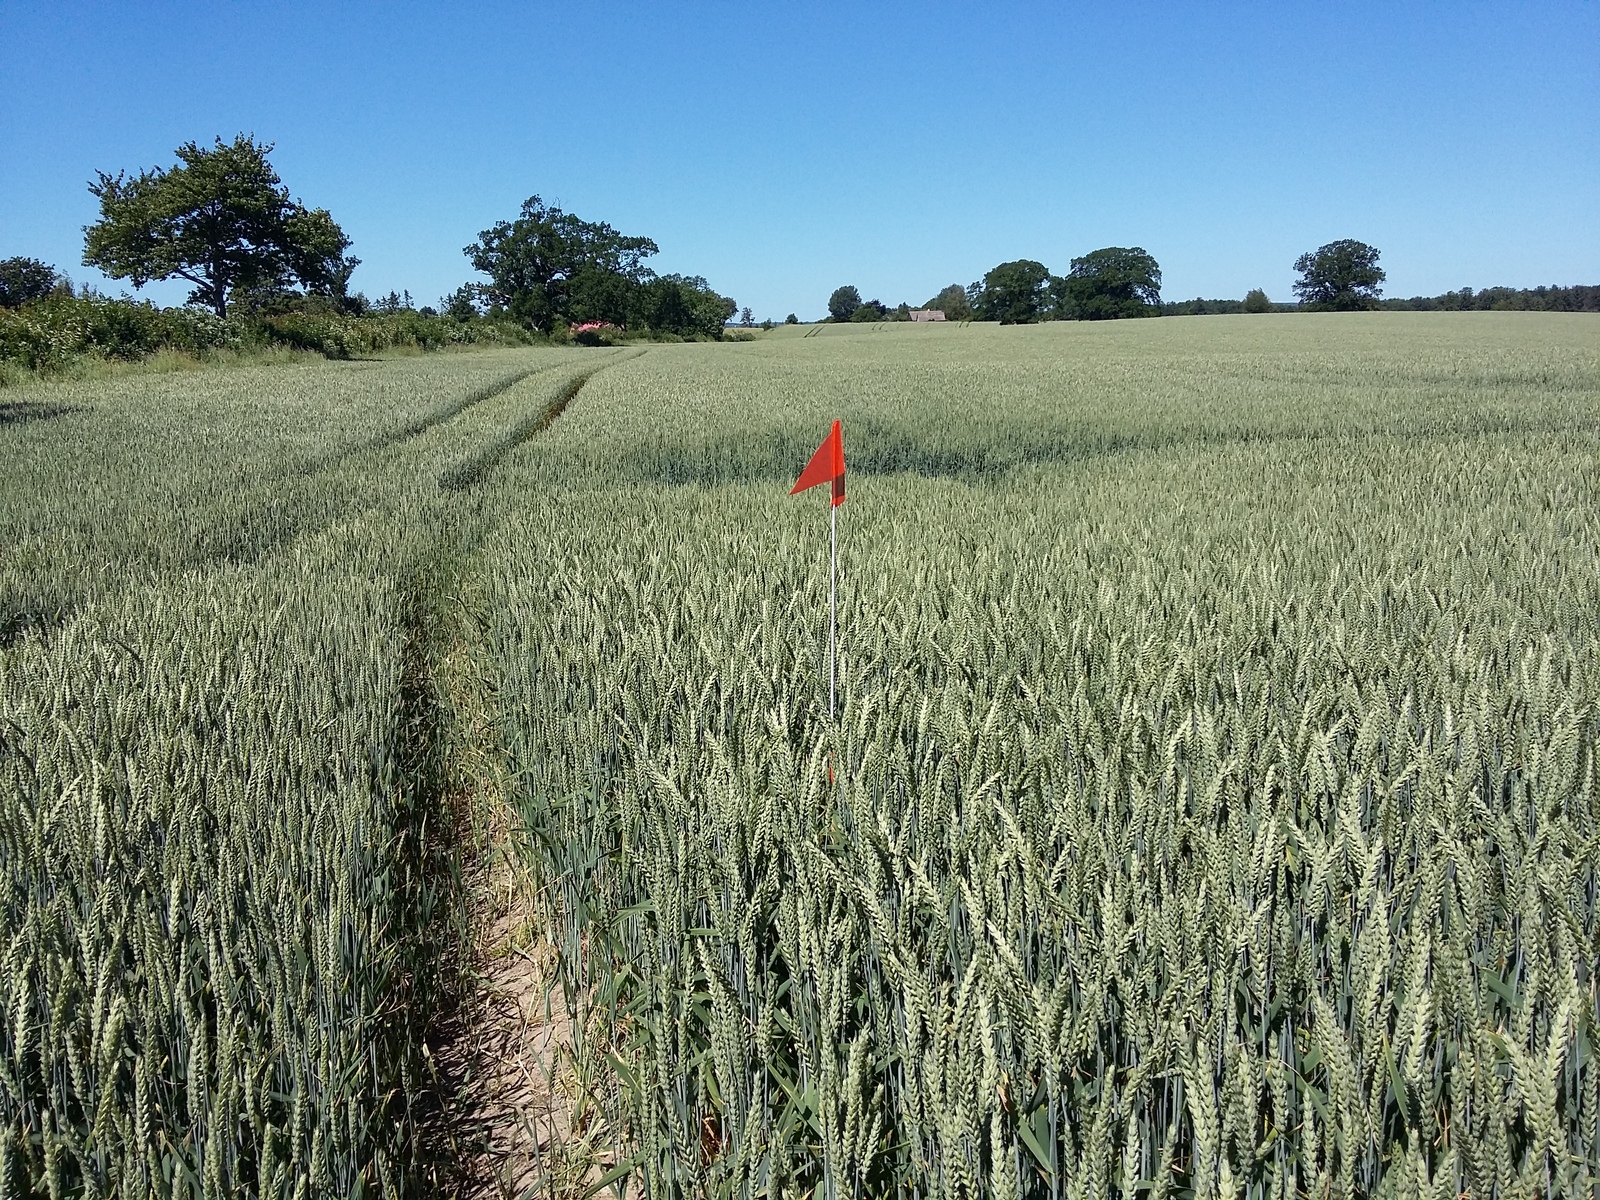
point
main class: Cropland
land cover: Common wheat
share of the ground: > 75 %
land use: Agriculture (excluding fallow land and kitchen gardens)
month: July
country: DK
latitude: 55.1290
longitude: 12.0217
